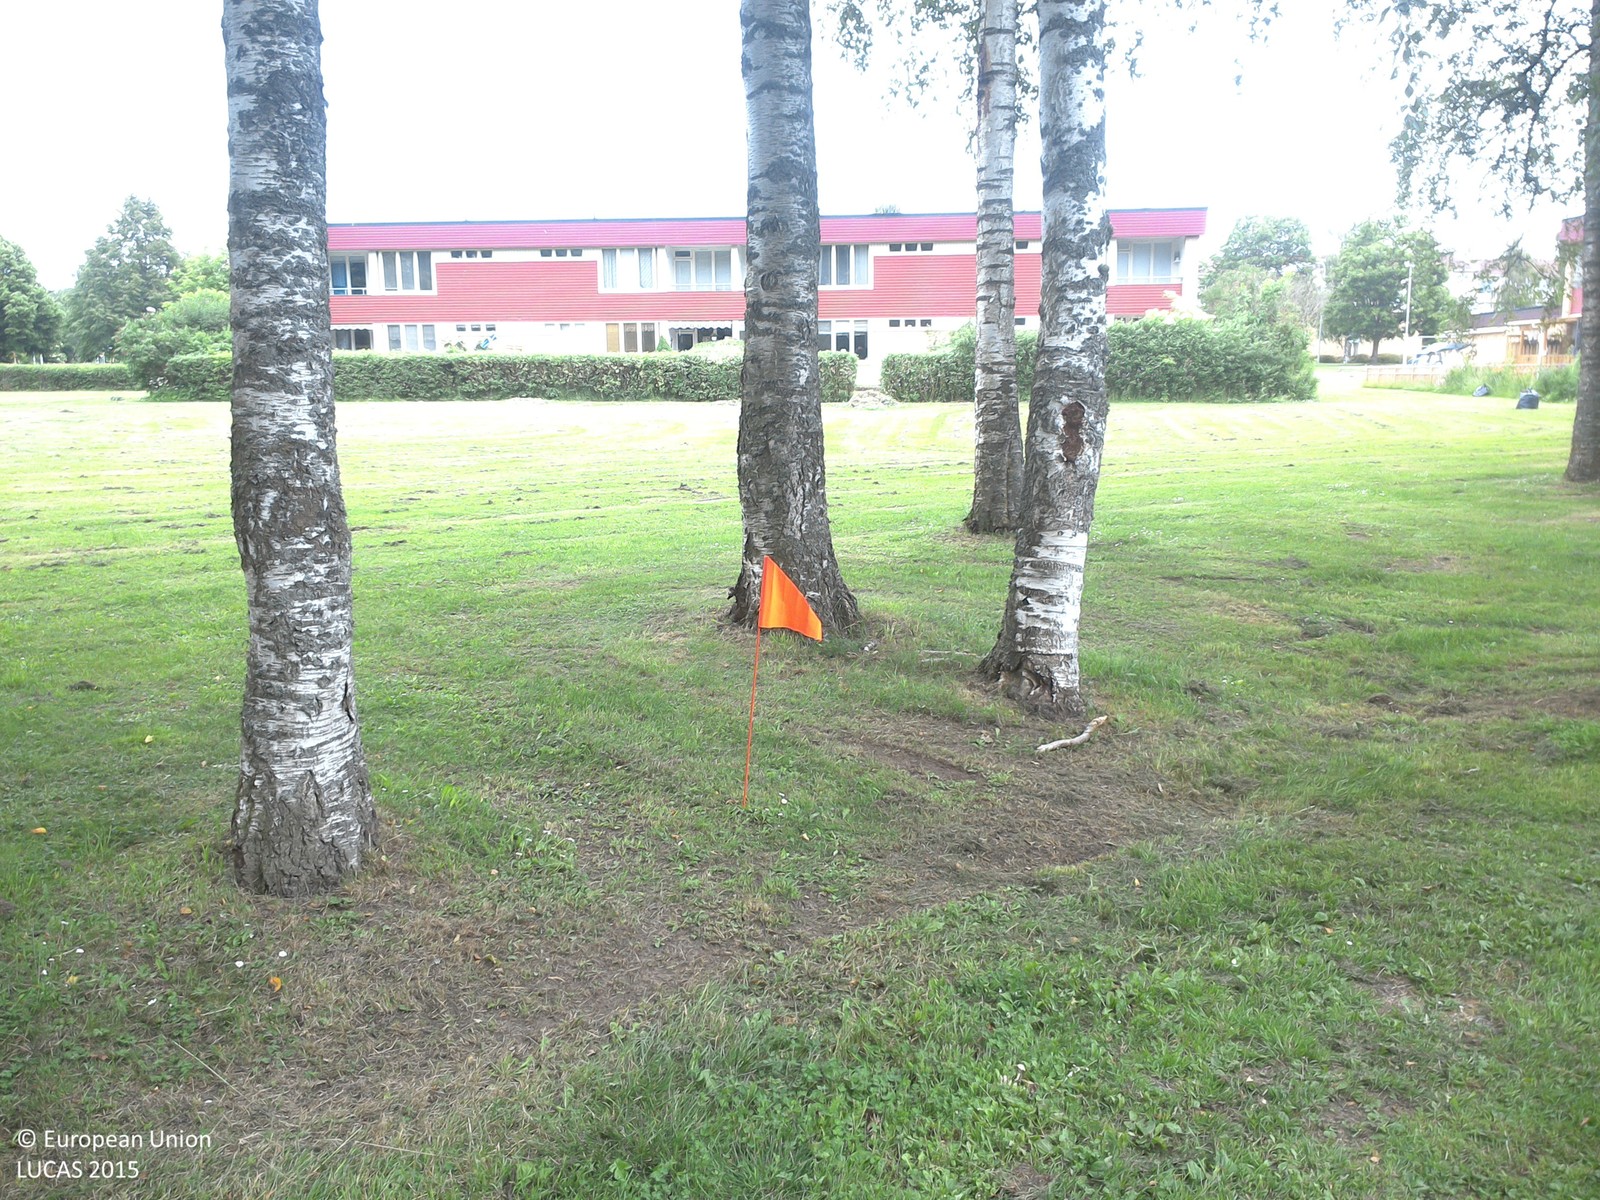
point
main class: Woodland
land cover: Broadleaved woodland
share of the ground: < 10 %
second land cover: Grassland without tree/shrub cover
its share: > 75 %
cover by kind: herbaceous plants 75 %, broadleaved forest trees 25 %
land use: Amenities, museums, leisure
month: June
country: SE
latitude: 58.4113
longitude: 15.5572
